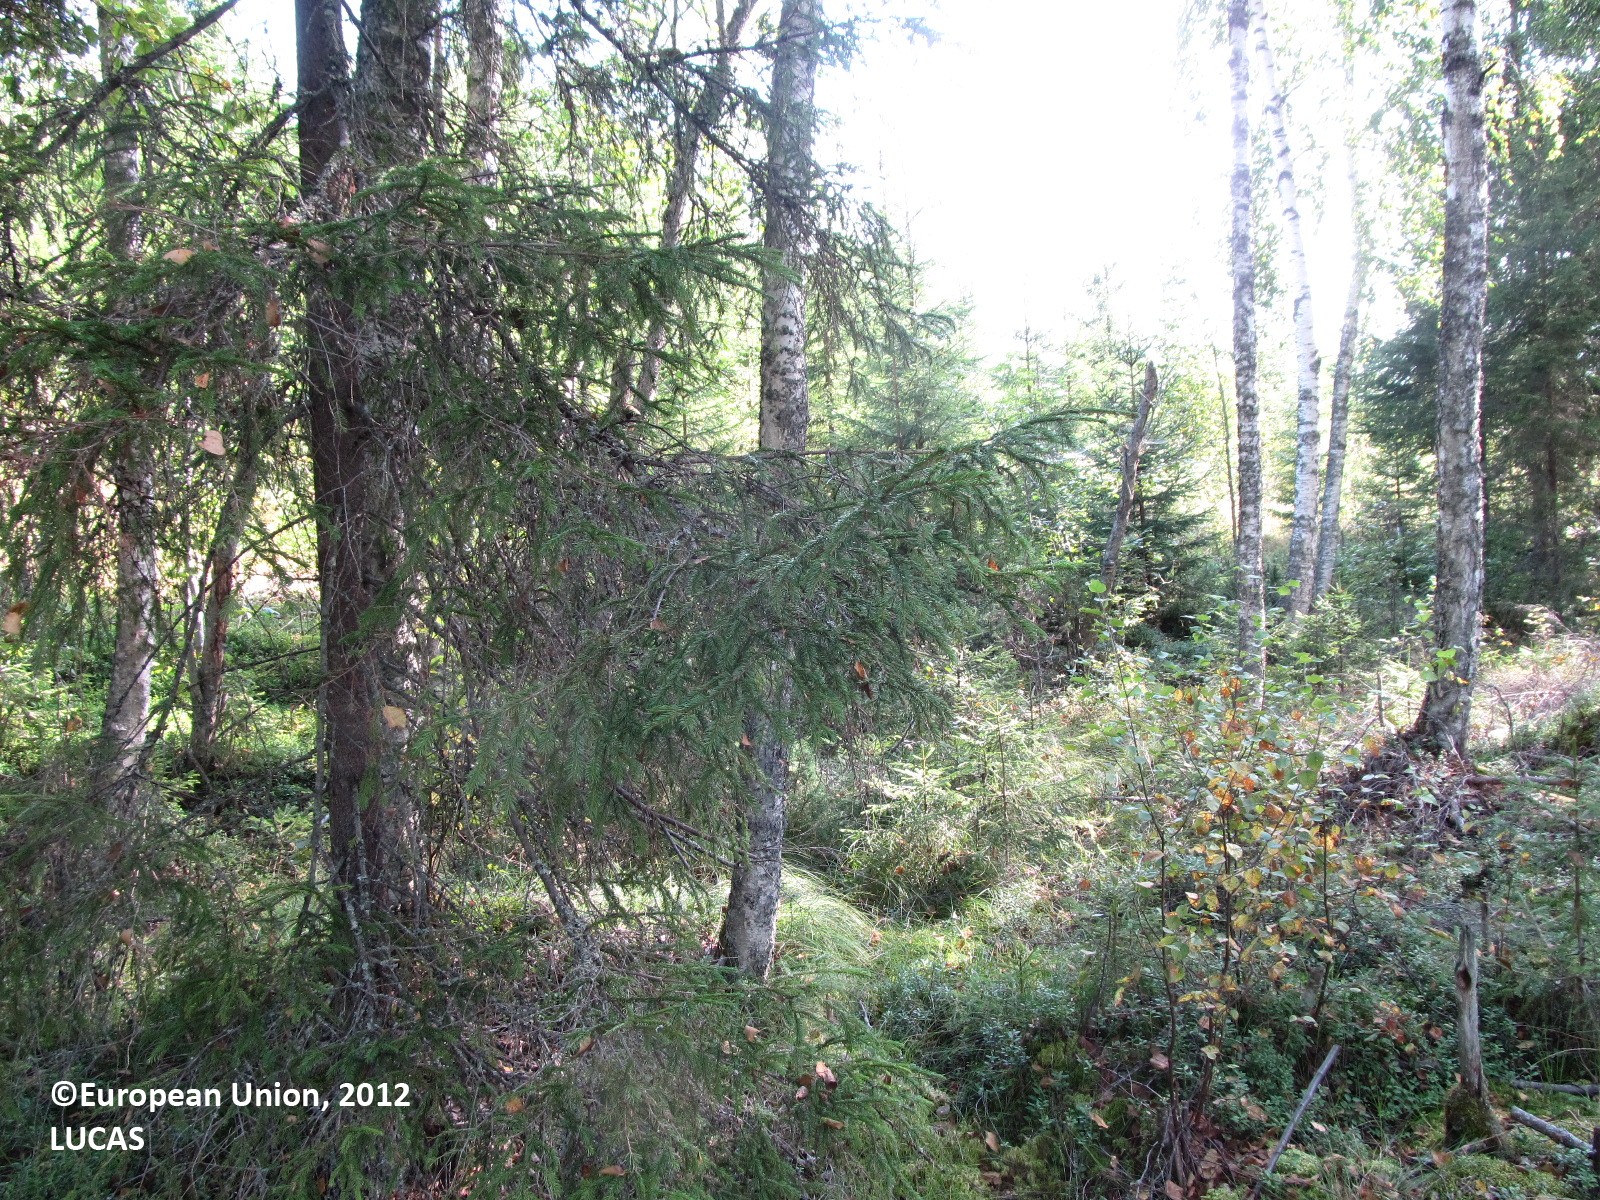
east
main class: Woodland
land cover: Pine dominated mixed woodland
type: boreal forest
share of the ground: > 75 %
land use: Forestry
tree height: > 5 m
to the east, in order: Pine dominated mixed woodland; Spruce dominated mixed woodland; Spruce dominated coniferous woodland; Spruce dominated mixed woodland; Broadleaved woodland; Paved roads, cycling and walking lanes; Ditches and canals; Broadleaved woodland; Spruce dominated mixed woodland; Ditches and canals; Pine dominated mixed woodland
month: August
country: FI
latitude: 62.4152
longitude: 27.4531
